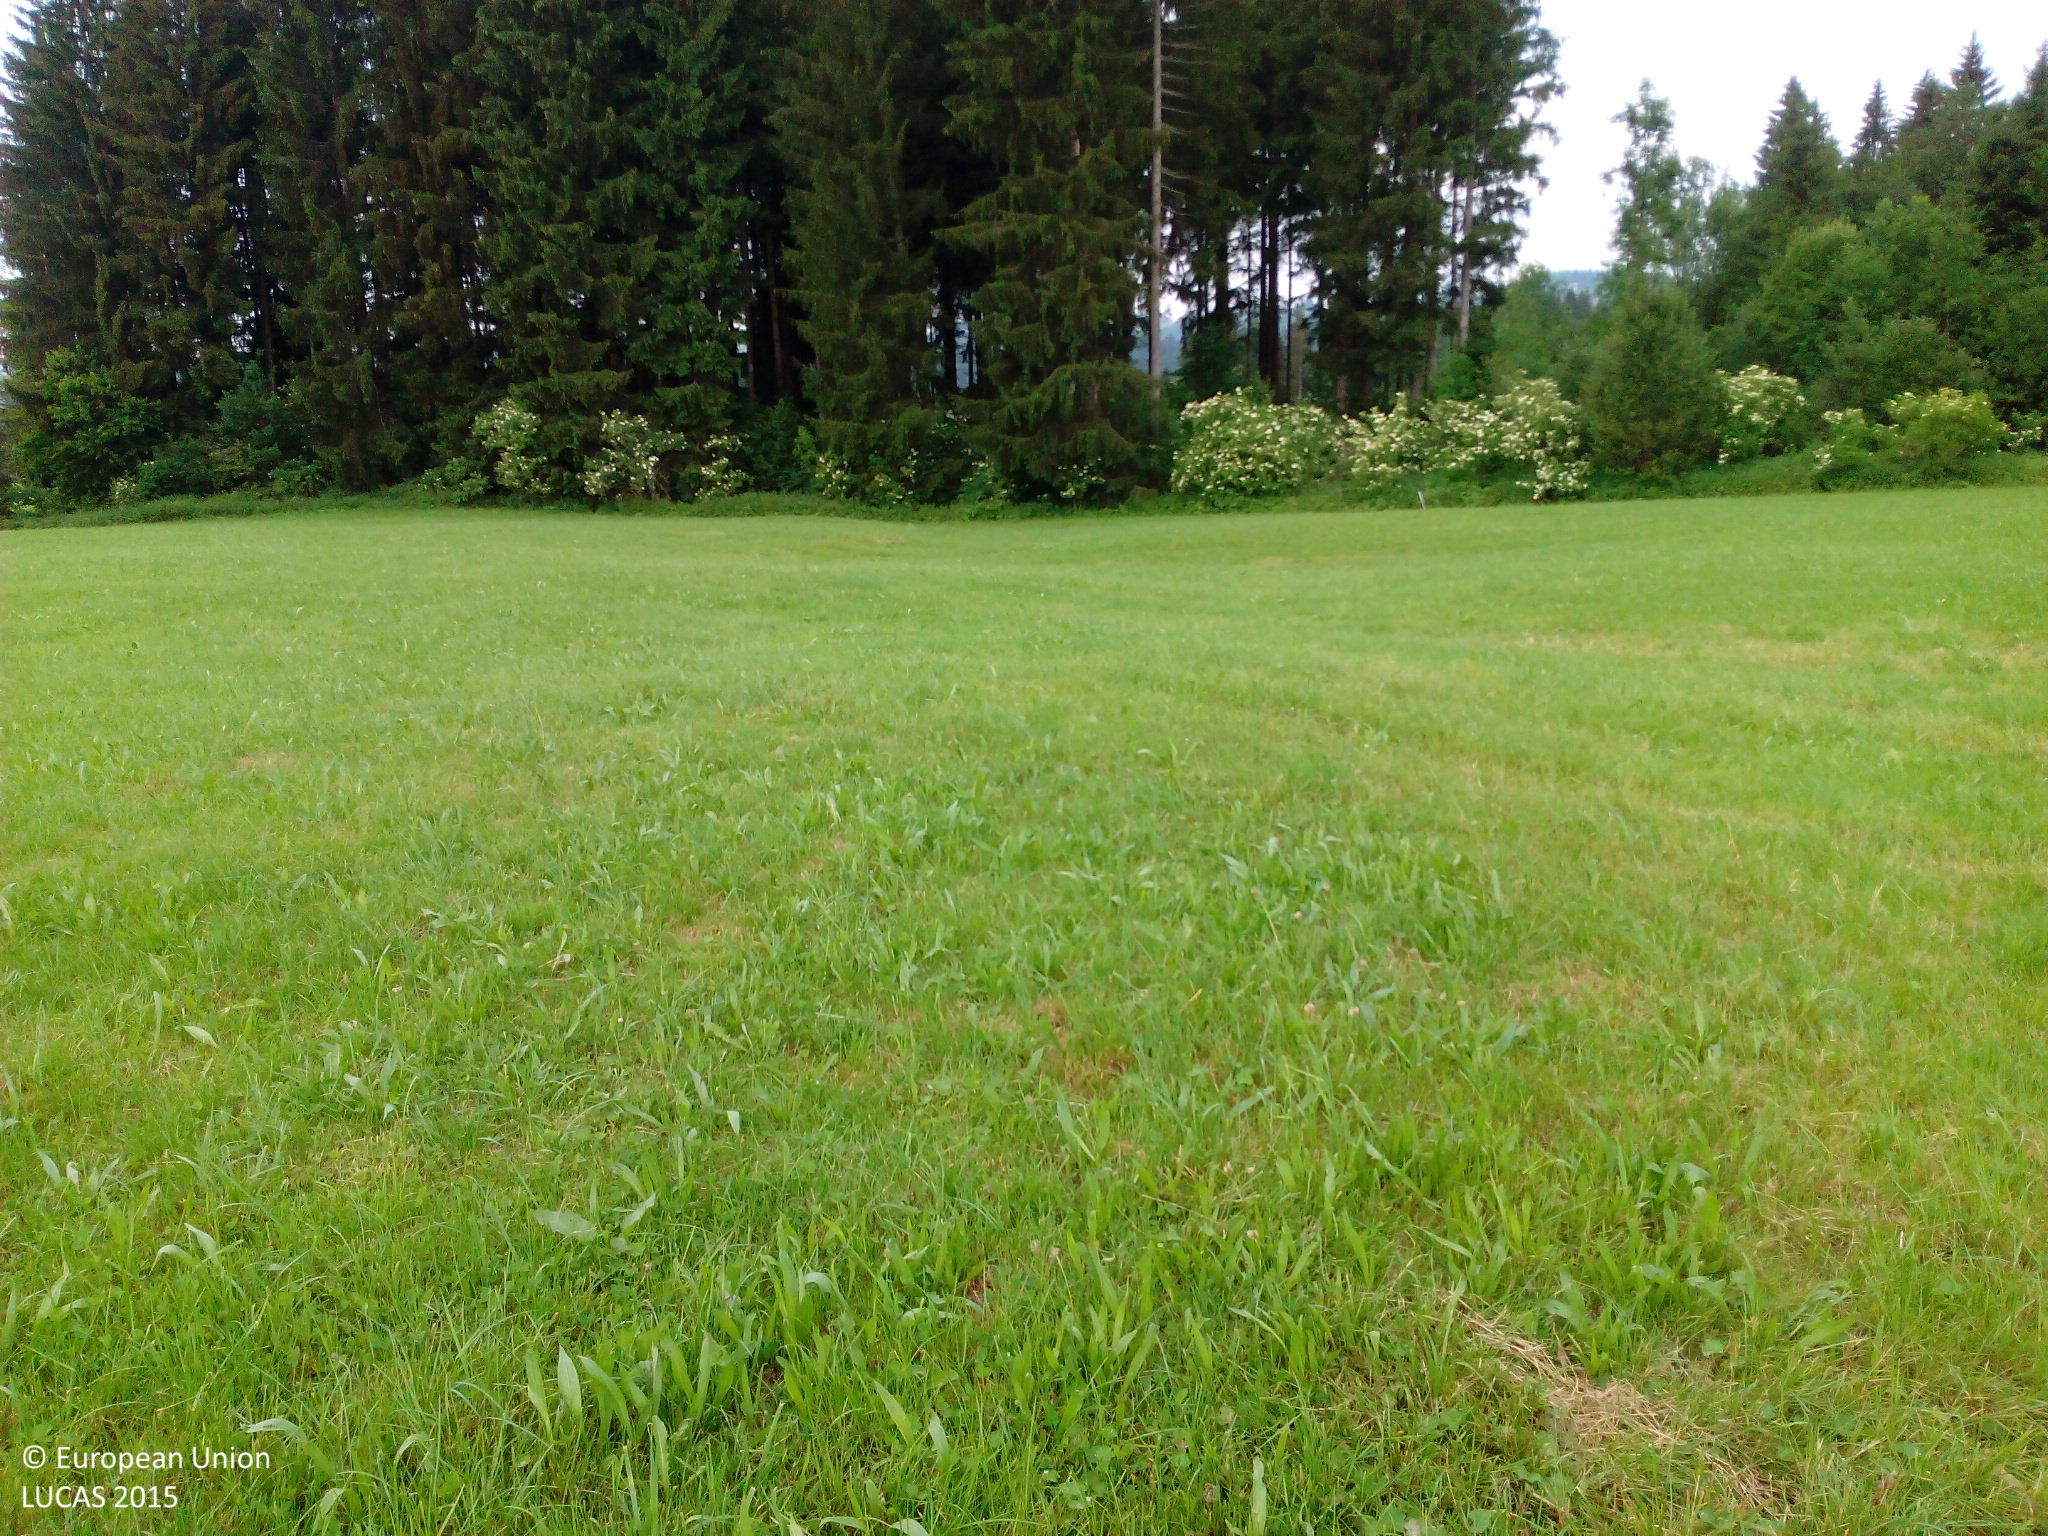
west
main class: Grassland
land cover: Grassland without tree/shrub cover
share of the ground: > 75 %
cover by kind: herbaceous plants 100 %
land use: Agriculture (excluding fallow land and kitchen gardens)
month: June
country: DE
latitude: 47.5936
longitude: 9.9336
